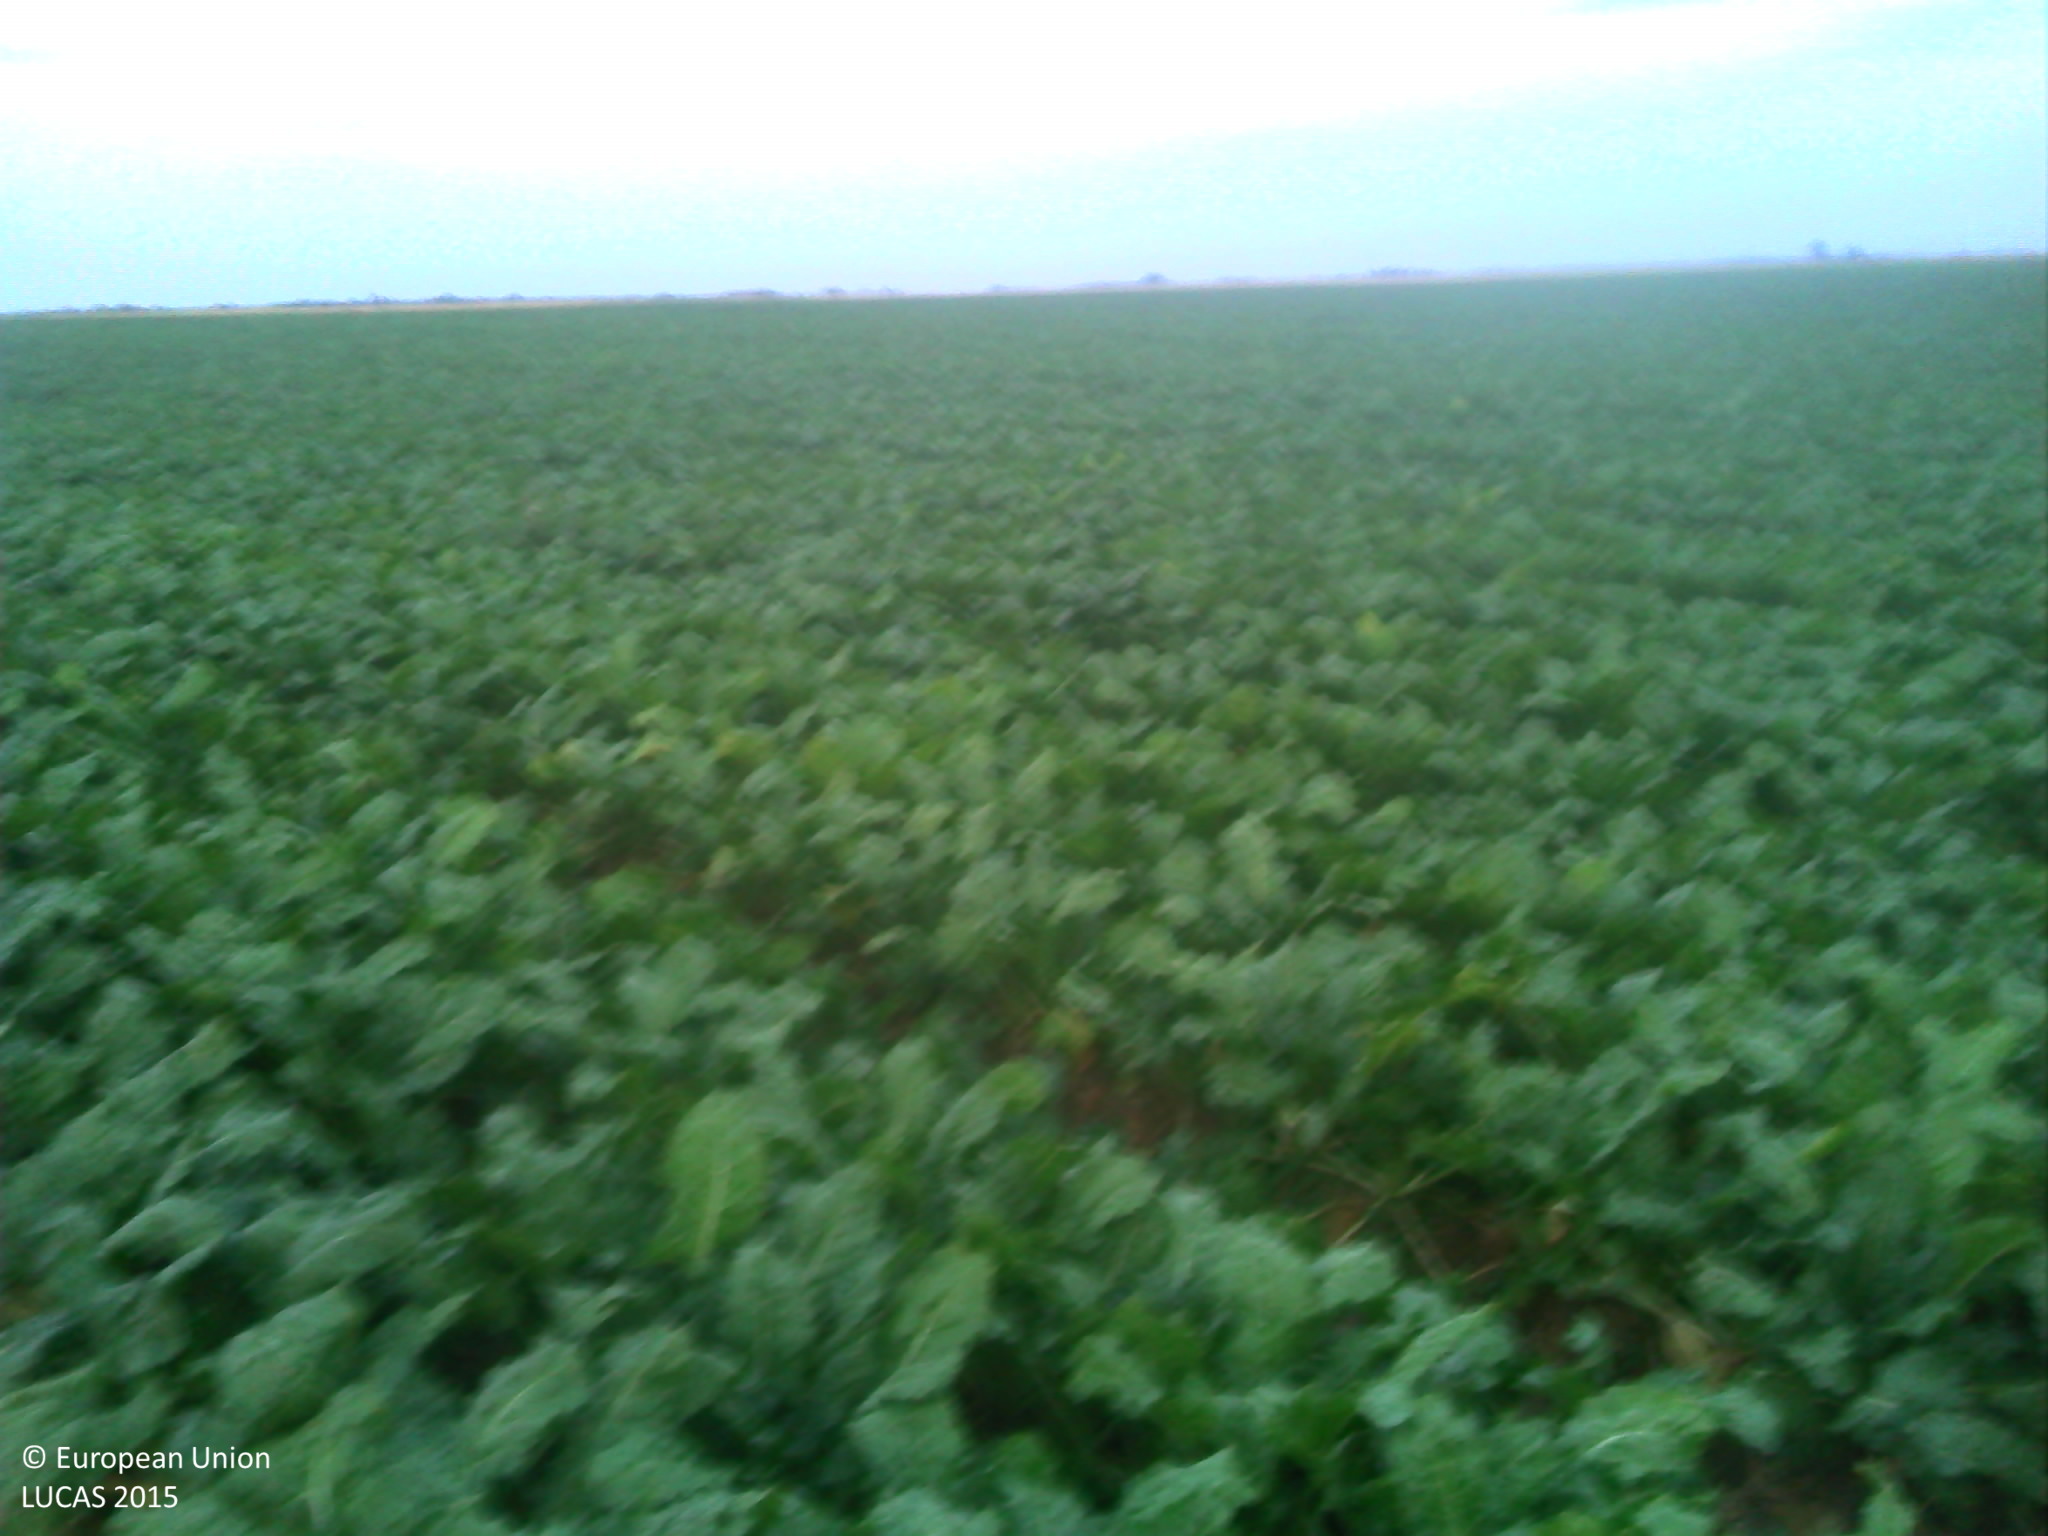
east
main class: Cropland
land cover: Sugar beet
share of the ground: > 75 %
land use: Agriculture (excluding fallow land and kitchen gardens)
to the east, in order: Sugar beet; Durum wheat
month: July
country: FR
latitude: 47.8281
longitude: 1.3411
